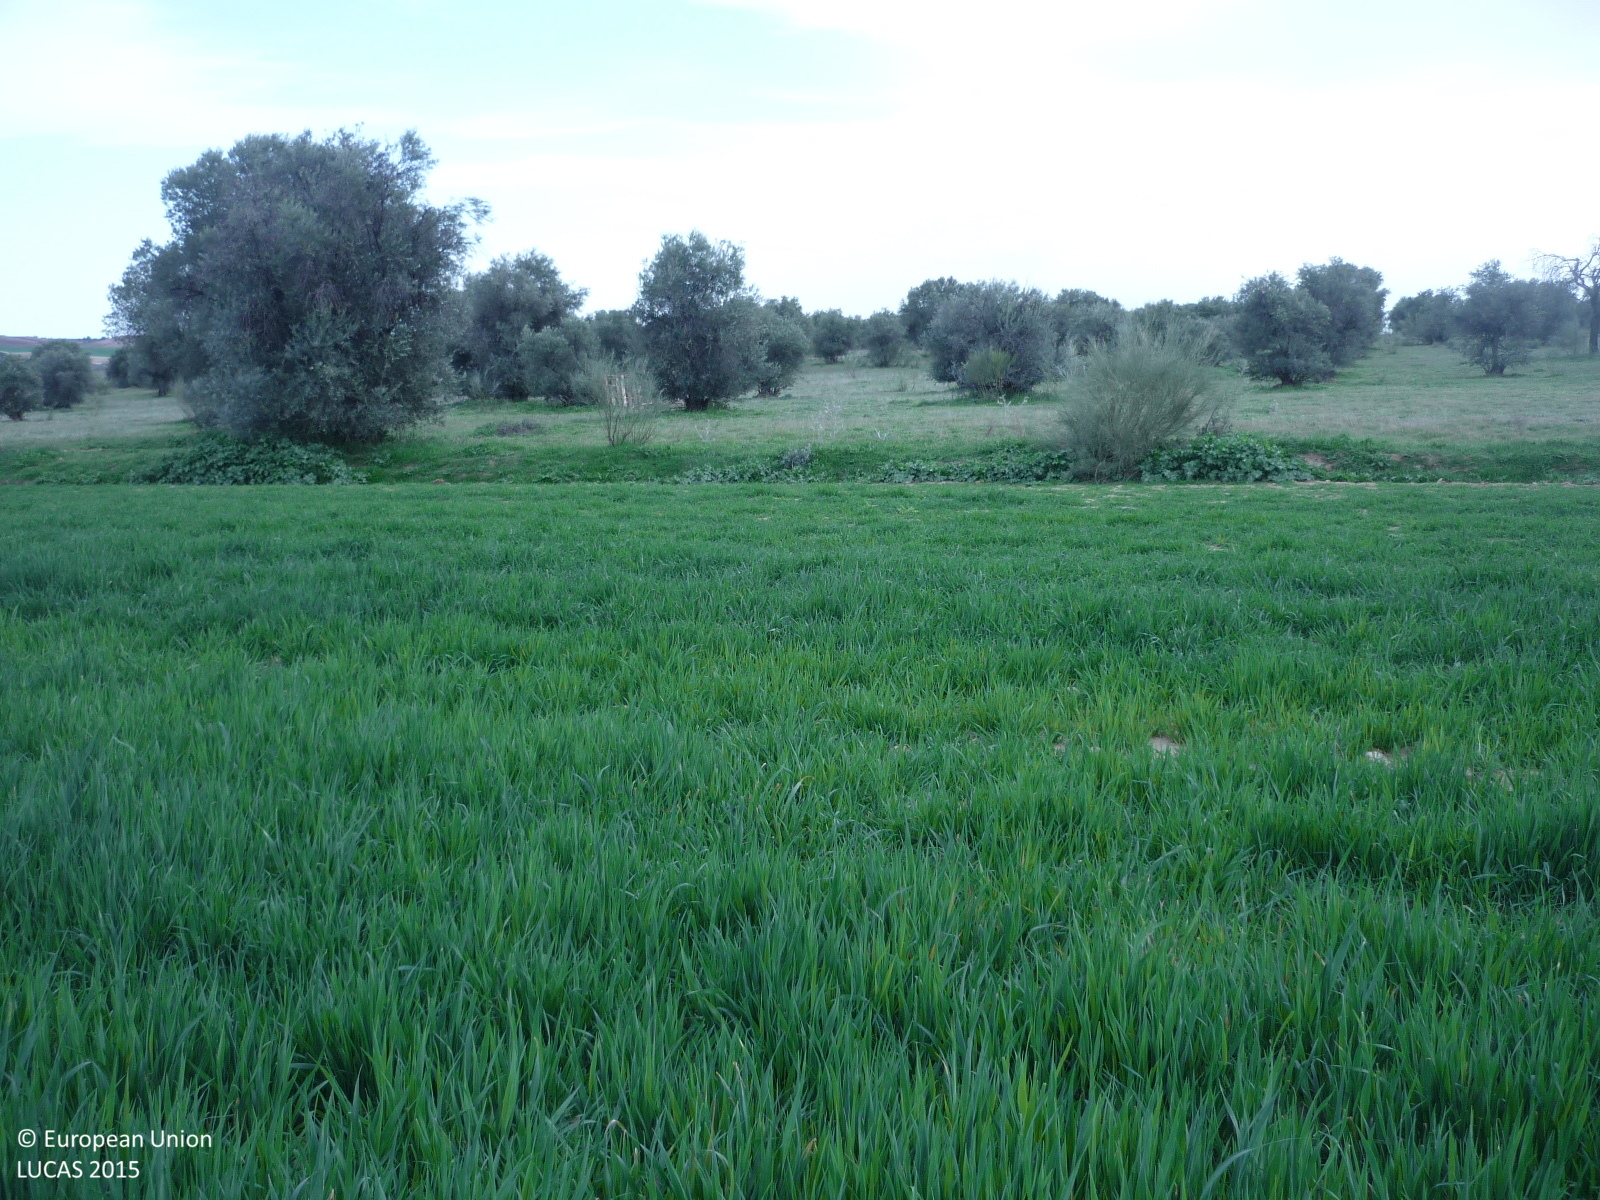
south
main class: Cropland
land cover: Rye
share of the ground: > 75 %
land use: Agriculture (excluding fallow land and kitchen gardens)
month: April
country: ES
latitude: 40.5854
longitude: -3.4221
